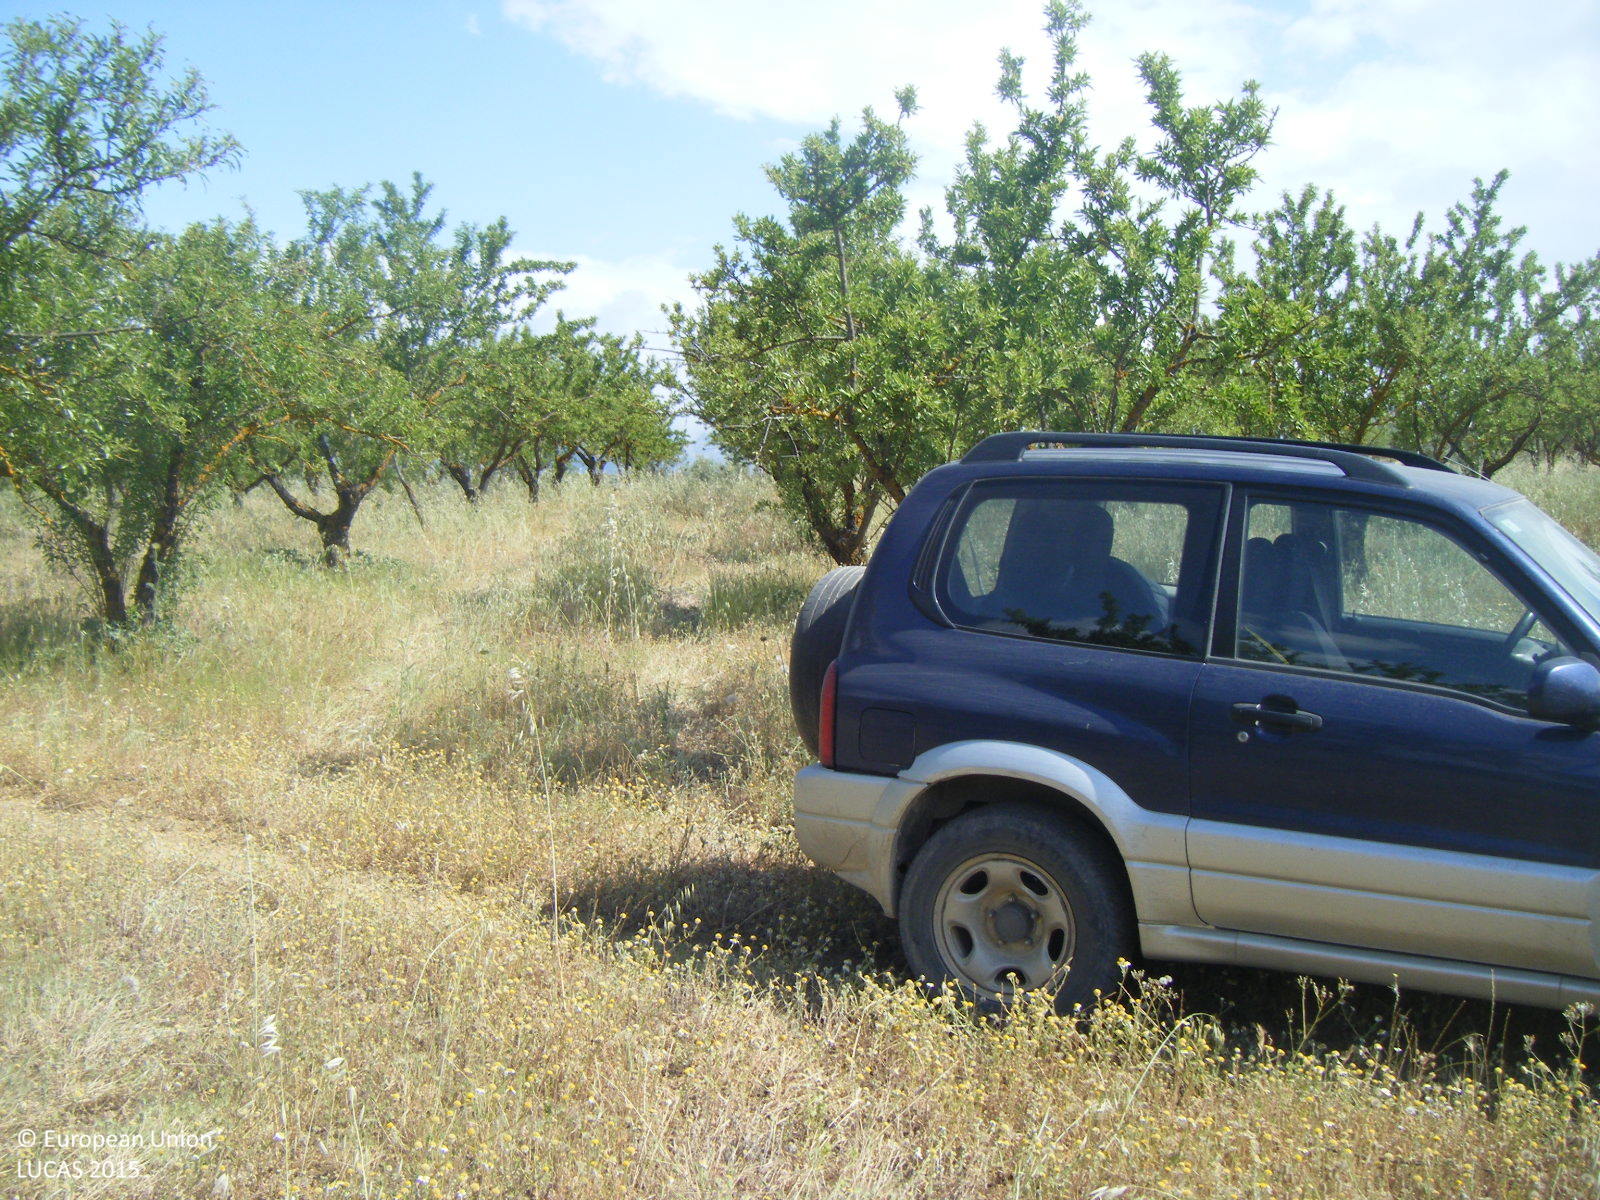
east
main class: Cropland
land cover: Nuts trees
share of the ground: 10 - 25 %
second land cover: Spontaneously vegetated surfaces
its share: > 75 %
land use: Agriculture (excluding fallow land and kitchen gardens)
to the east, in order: Nuts trees; Spontaneously vegetated surfaces; Tracks; Fences; Olive groves; Fences; Tracks; Olive groves; Tracks
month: May
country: ES
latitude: 37.0534
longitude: -4.3774
